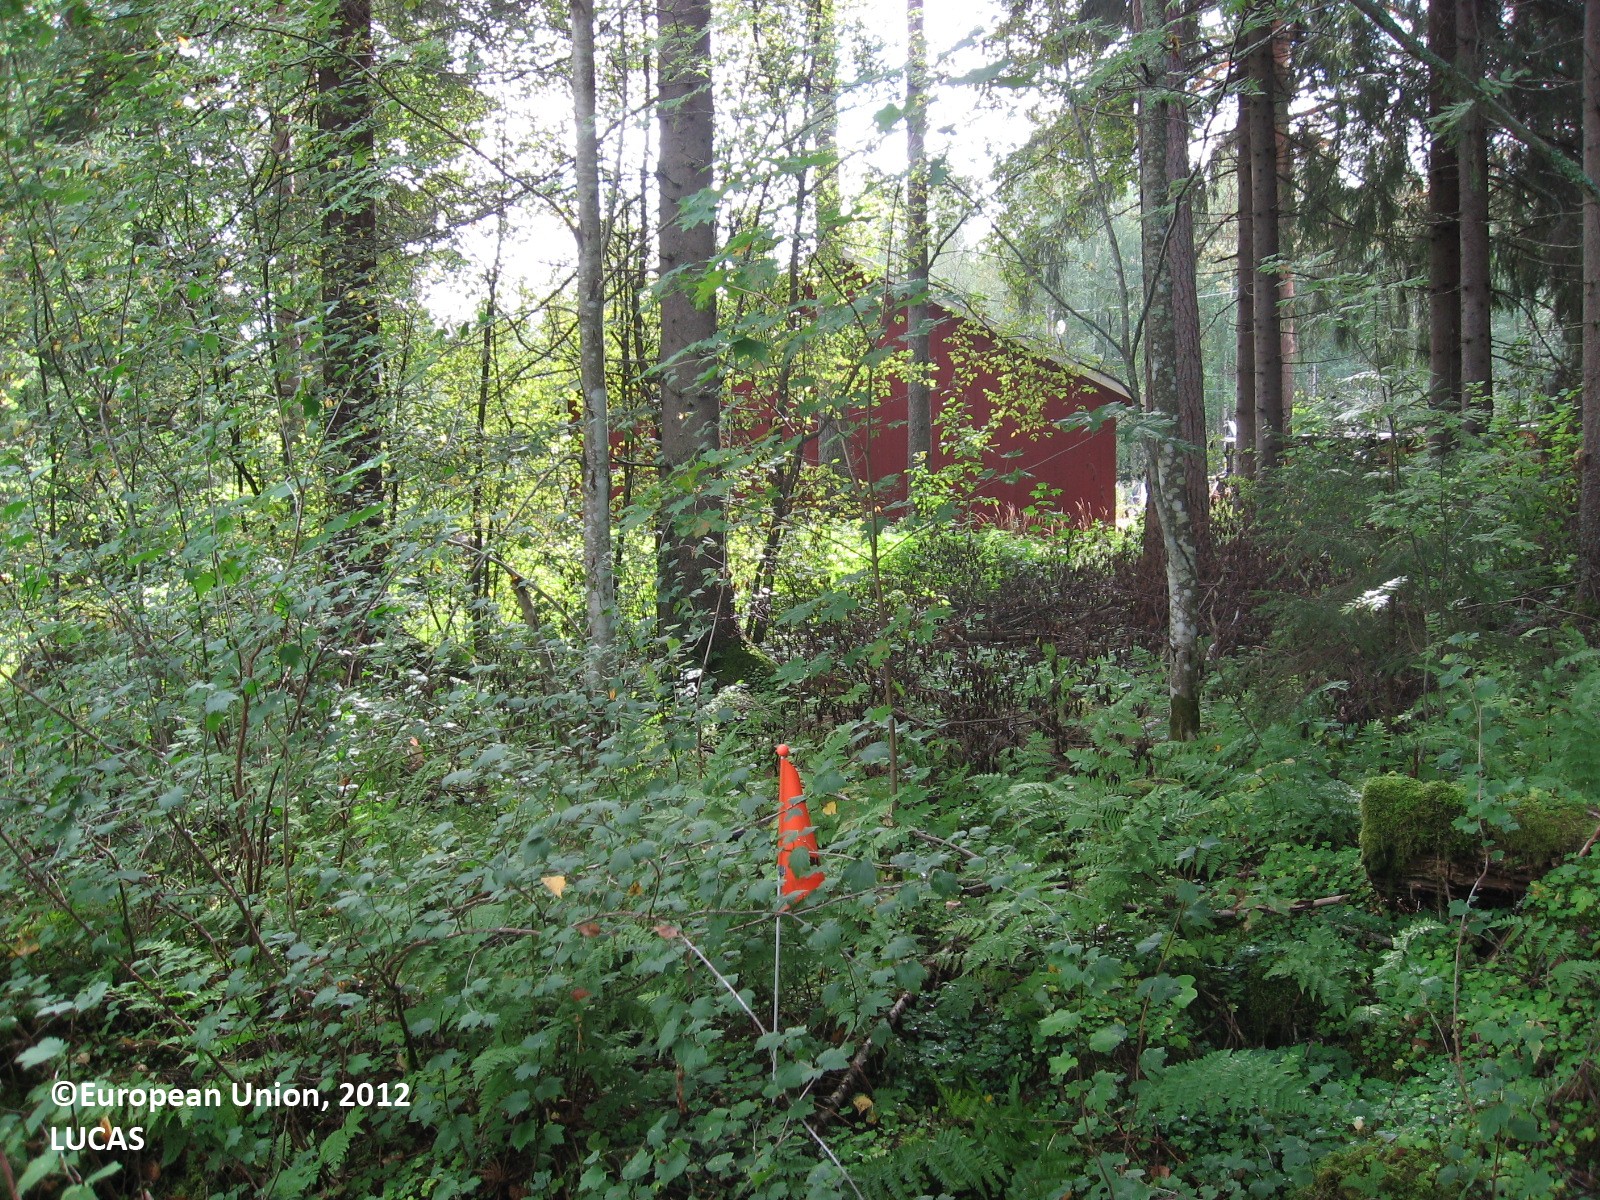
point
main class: Woodland
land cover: Spruce dominated mixed woodland
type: boreal forest
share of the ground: > 75 %
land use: Forestry
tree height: > 5 m
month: August
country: FI
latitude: 61.4475
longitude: 25.0206
